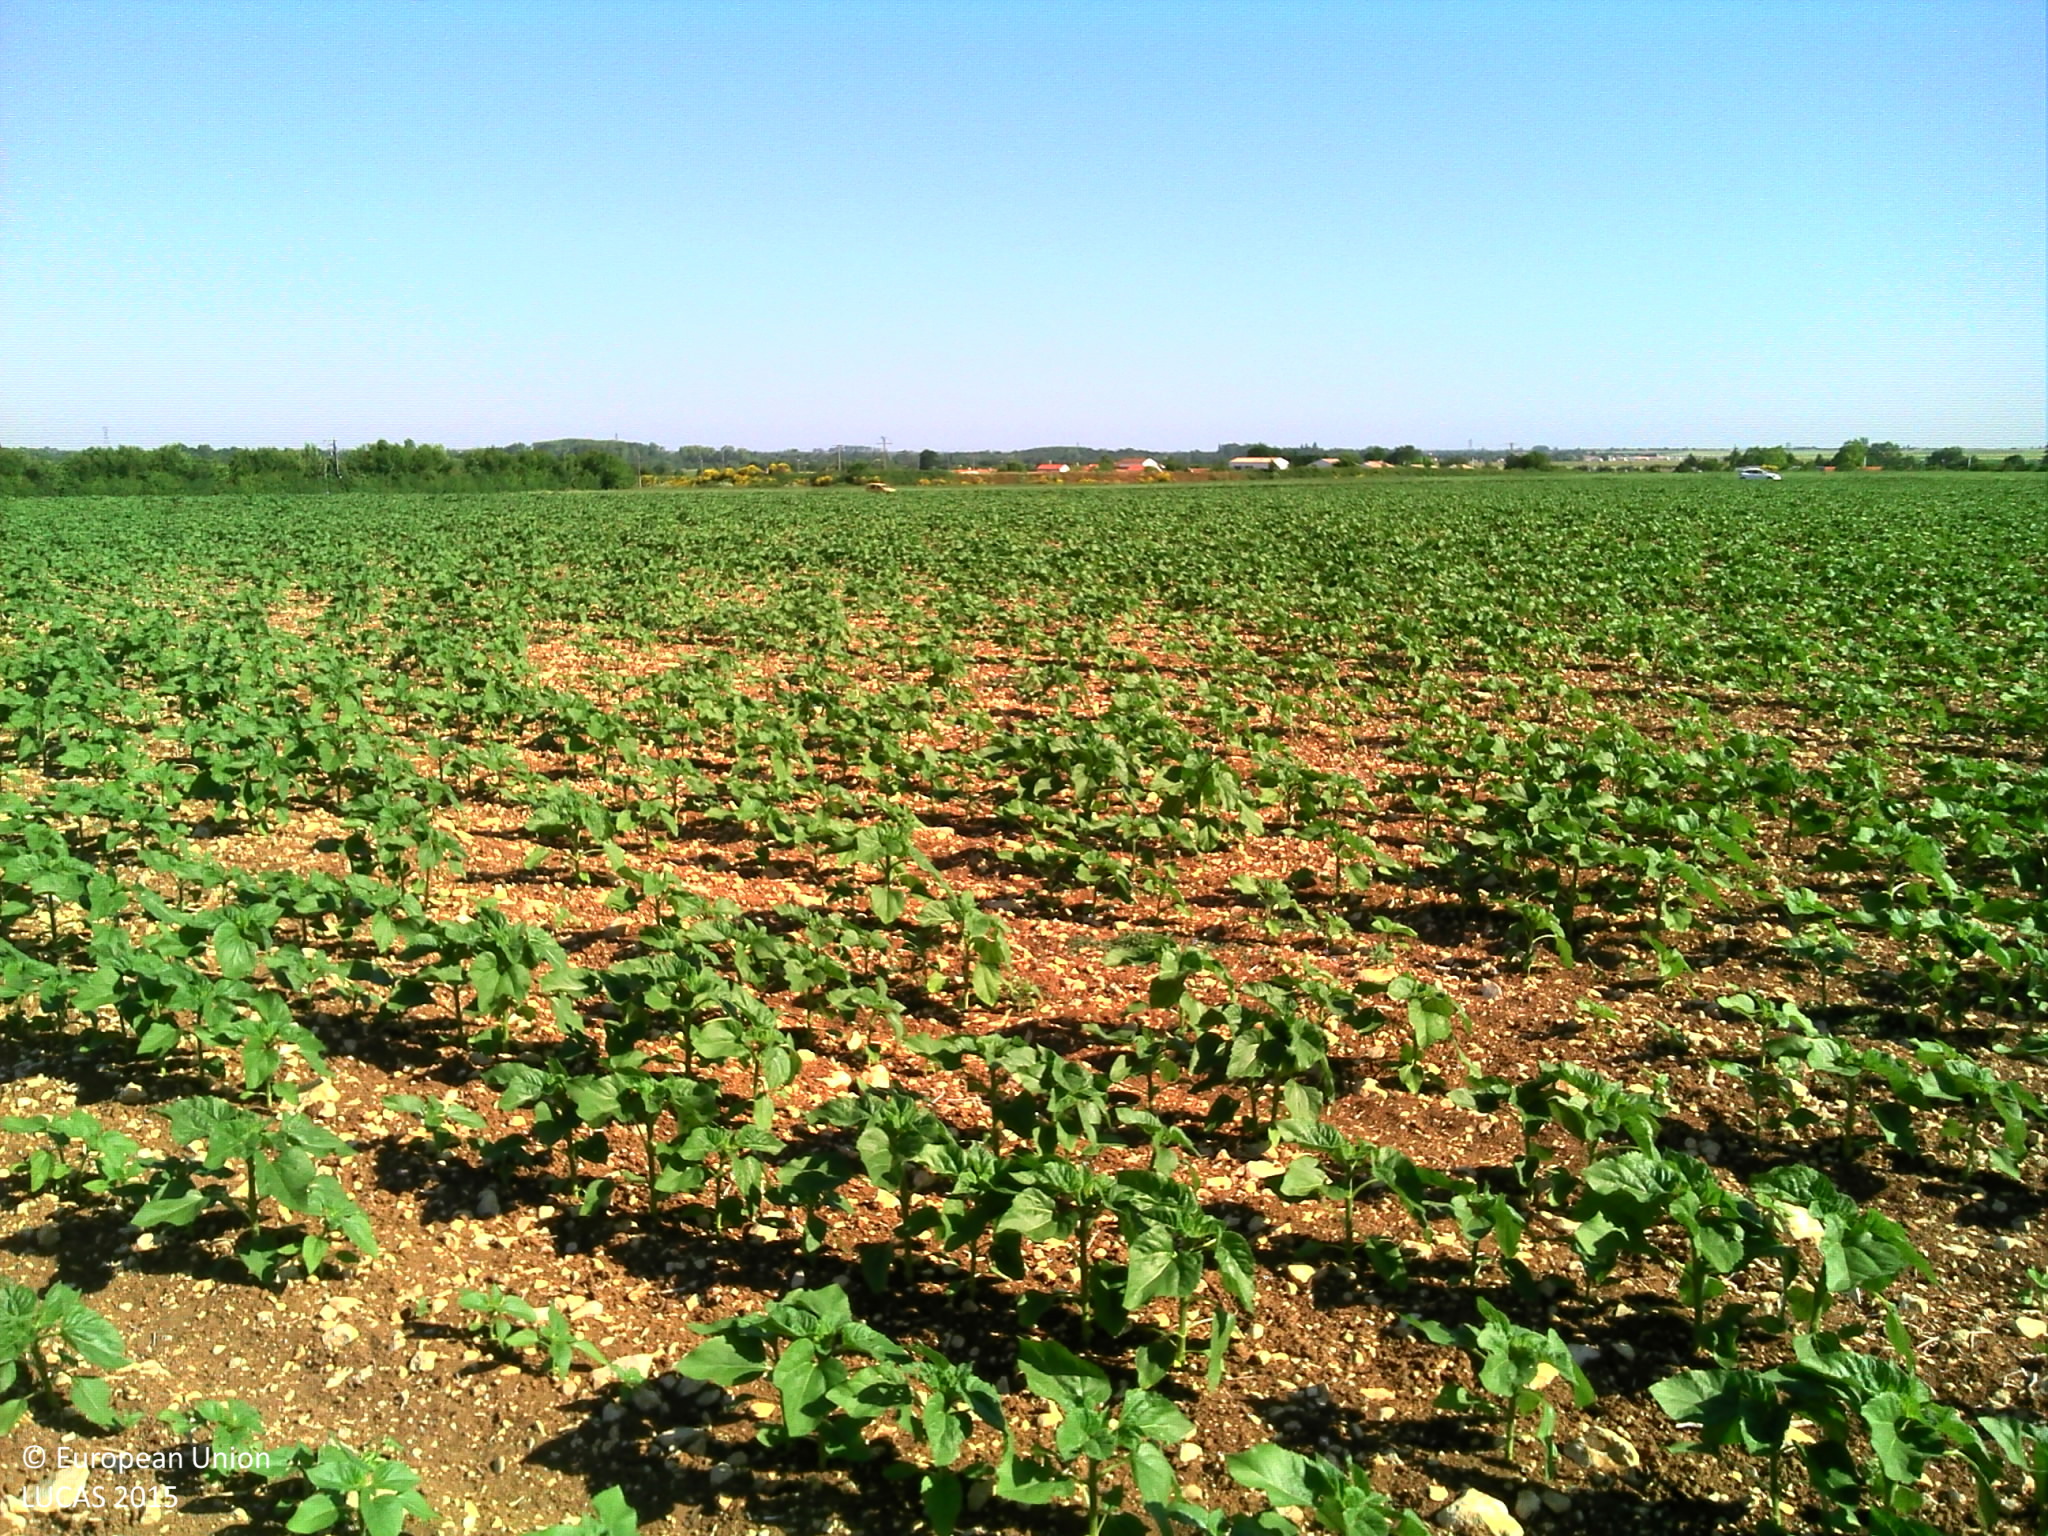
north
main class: Cropland
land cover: Sunflower
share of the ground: > 75 %
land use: Agriculture (excluding fallow land and kitchen gardens)
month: June
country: FR
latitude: 46.1966
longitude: -1.0324
